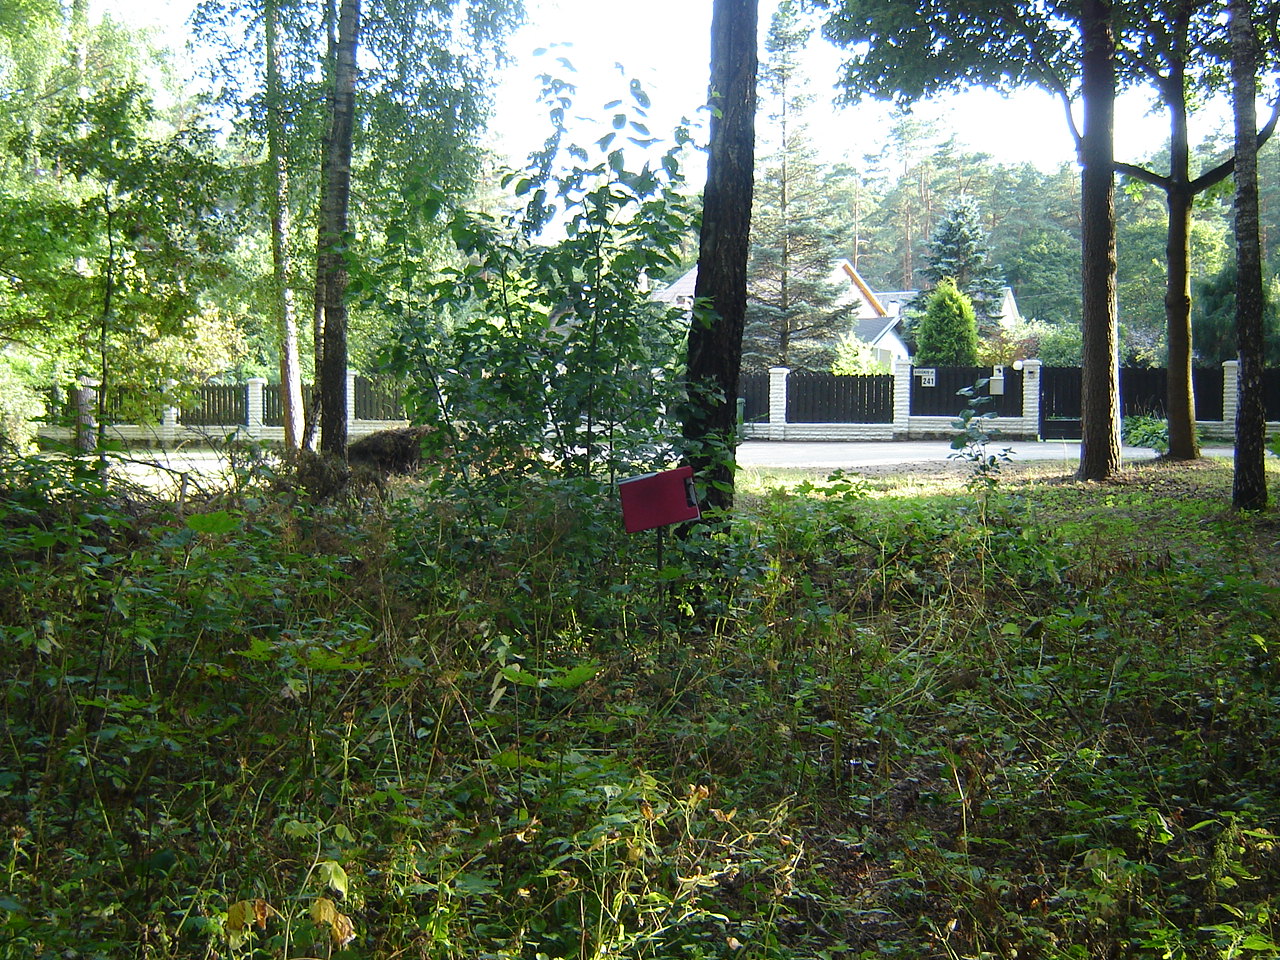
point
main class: Woodland
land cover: Pine dominated mixed woodland
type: hemiboreal forest and nemoral coniferous forest and mixed broadleaved-coniferous forest
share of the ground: > 75 %
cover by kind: coniferous forest trees 55 %, broadleaved forest trees 30 %, herbaceous plants 15 %
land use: Forestry
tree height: > 5 m
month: August
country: LT
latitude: 54.6125
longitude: 25.2167
